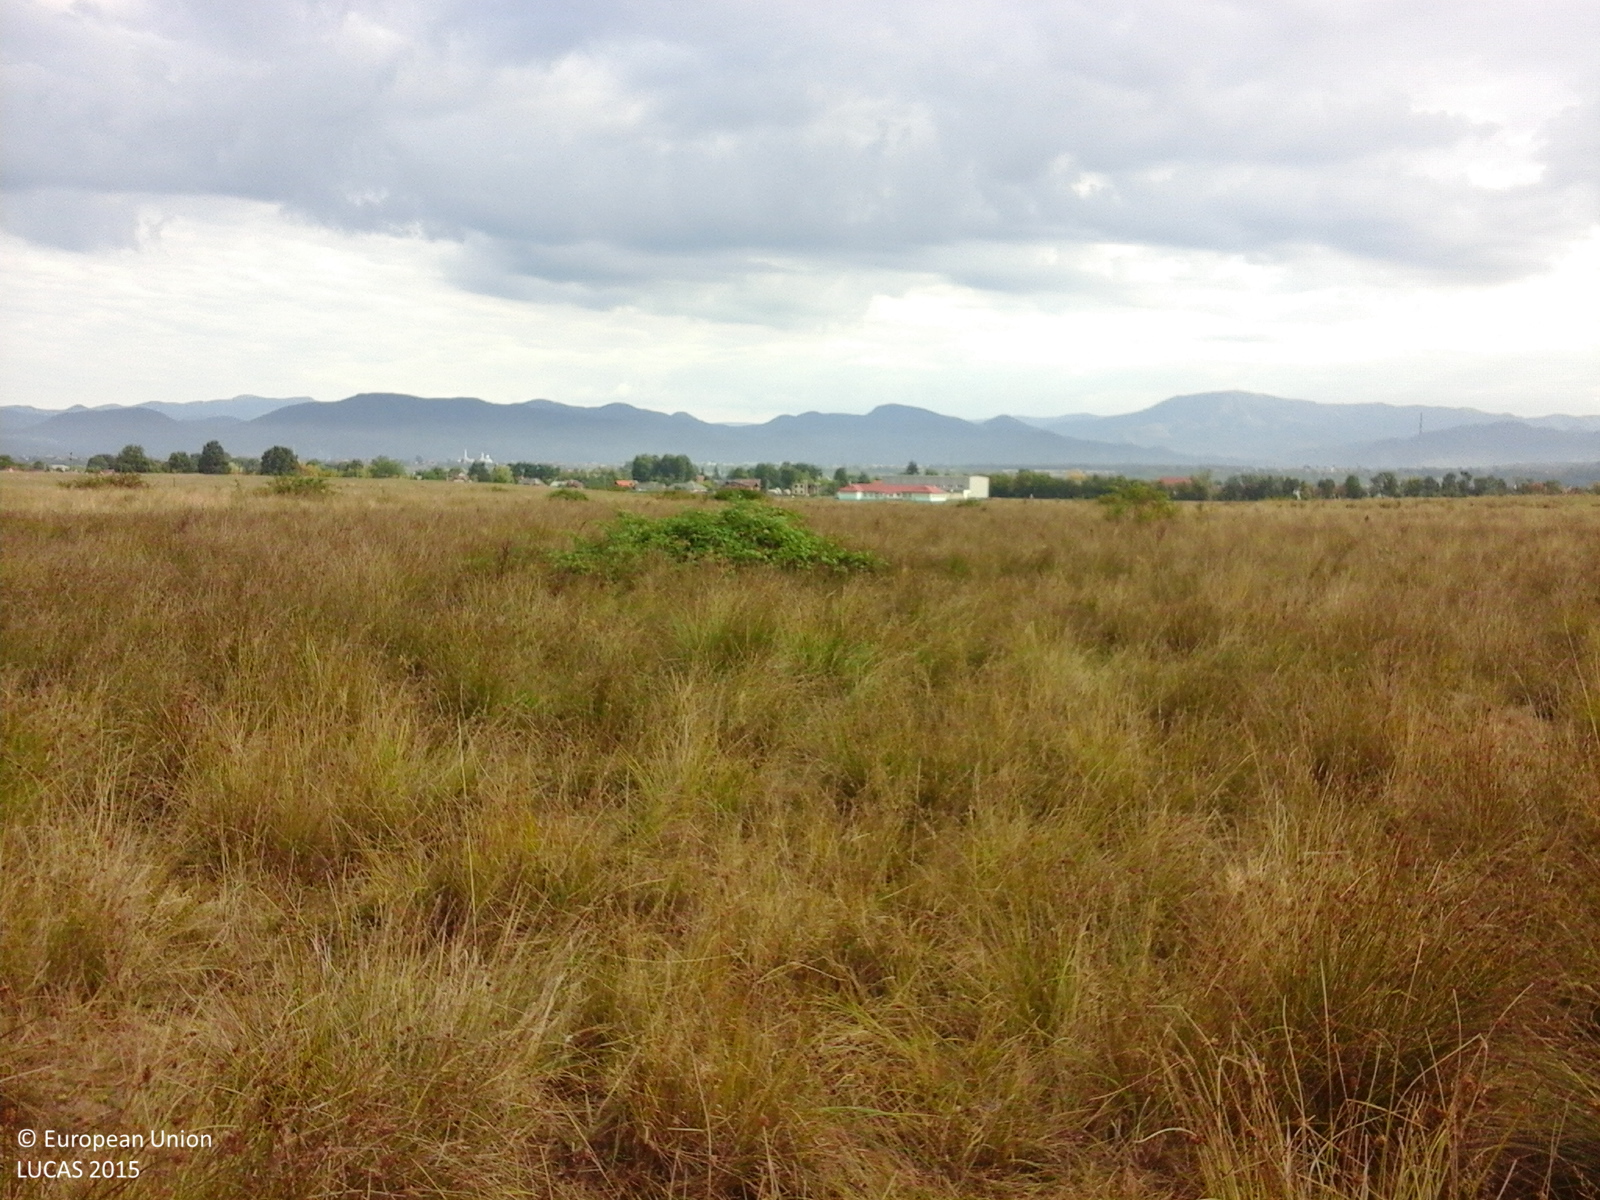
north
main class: Grassland
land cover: Grassland without tree/shrub cover
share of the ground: > 75 %
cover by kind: herbaceous plants 100 %
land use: Agriculture (excluding fallow land and kitchen gardens)
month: September
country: RO
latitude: 47.5868
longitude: 23.5180
